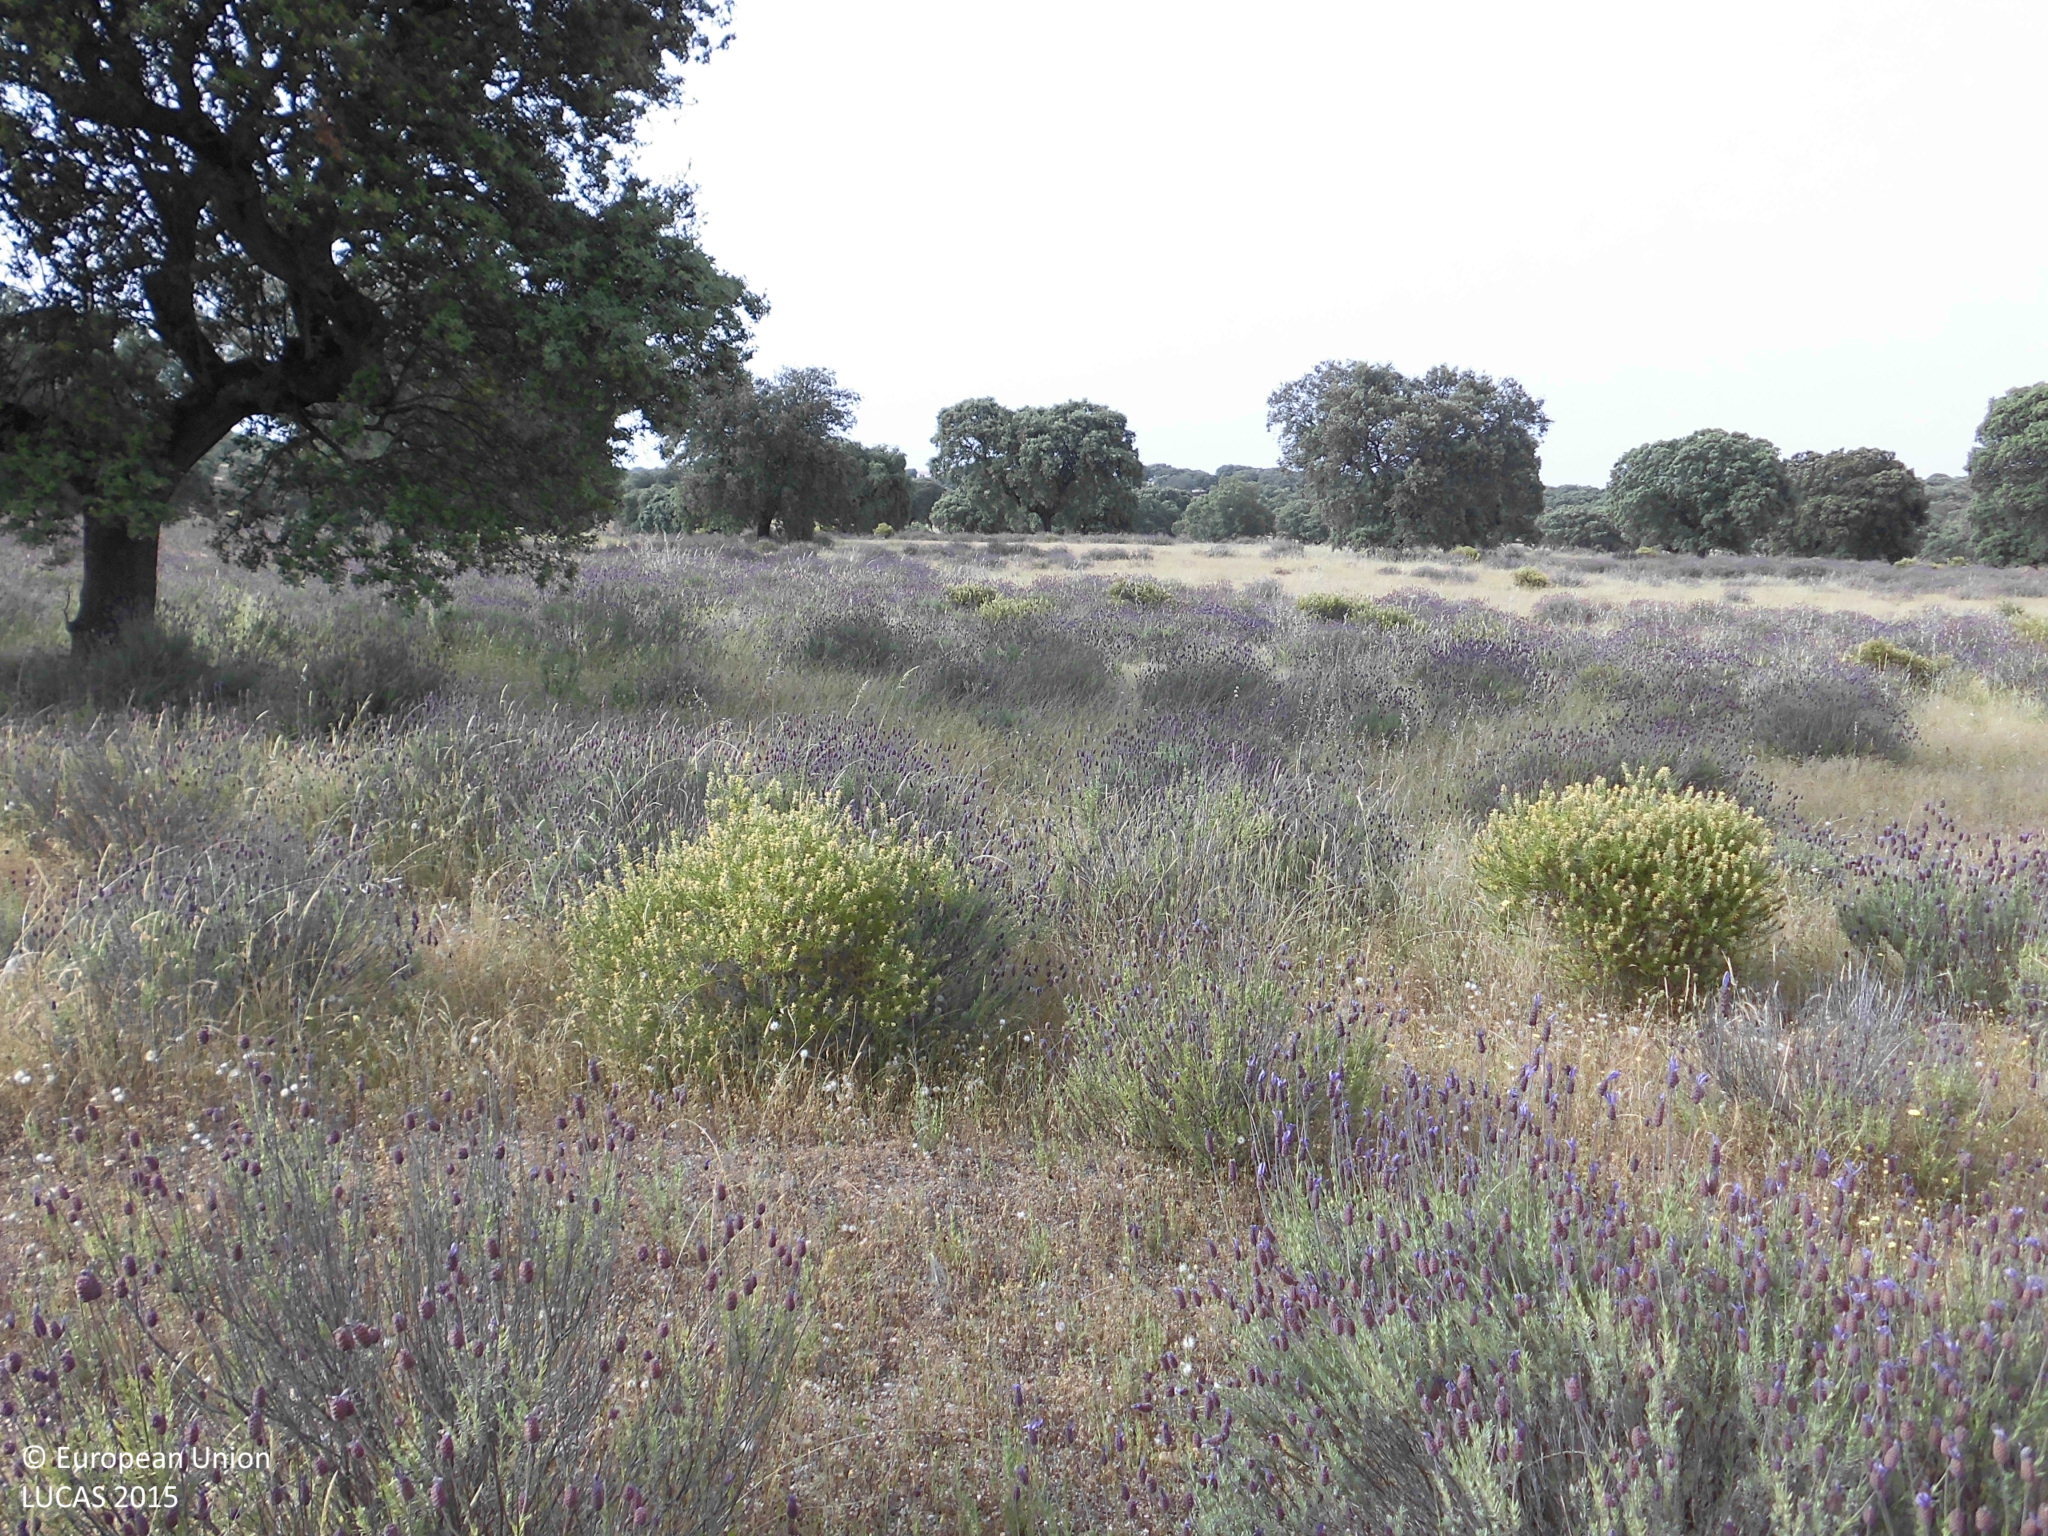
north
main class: Woodland
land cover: Broadleaved woodland
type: broadleaved evergreen forest
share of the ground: 25 - 50 %
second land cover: Grassland without tree/shrub cover
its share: > 75 %
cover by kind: herbaceous plants 55 %, broadleaved forest trees 30 %, shrubs 15 %
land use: Forestry
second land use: Agriculture (excluding fallow land and kitchen gardens)
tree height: > 5 m
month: May
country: ES
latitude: 39.6575
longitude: -6.1390
